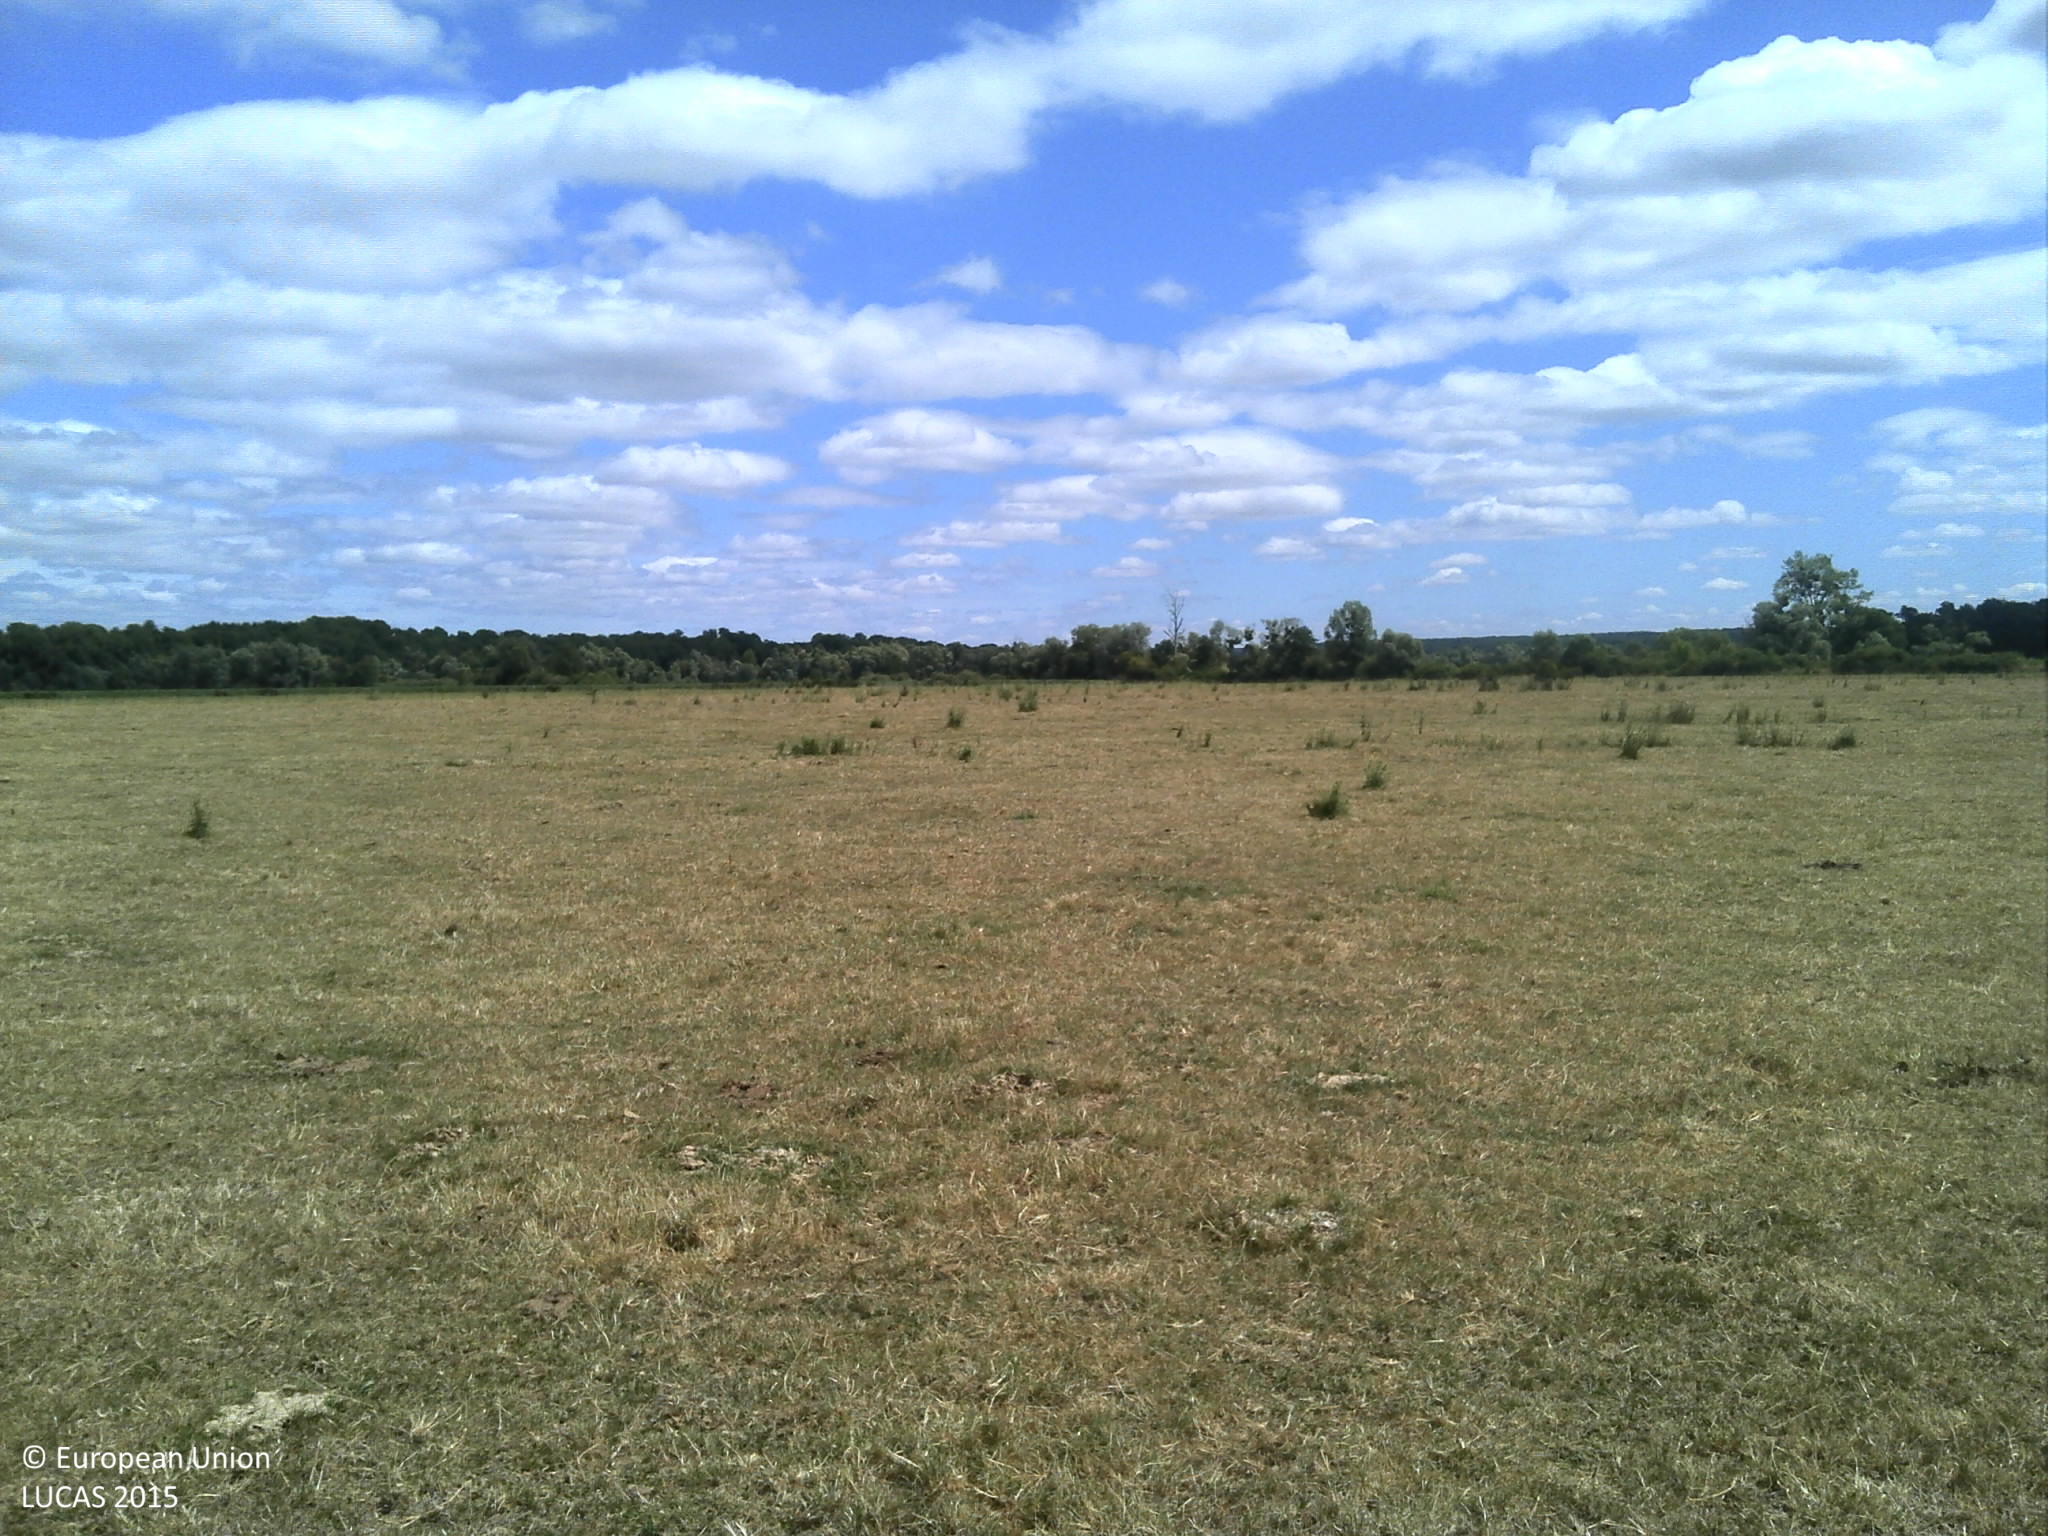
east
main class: Grassland
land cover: Grassland without tree/shrub cover
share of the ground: > 75 %
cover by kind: herbaceous plants 100 %
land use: Agriculture (excluding fallow land and kitchen gardens)
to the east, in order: Grassland without tree/shrub cover; Fences; Grassland without tree/shrub cover
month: July
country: FR
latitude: 49.3067
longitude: 4.7569
